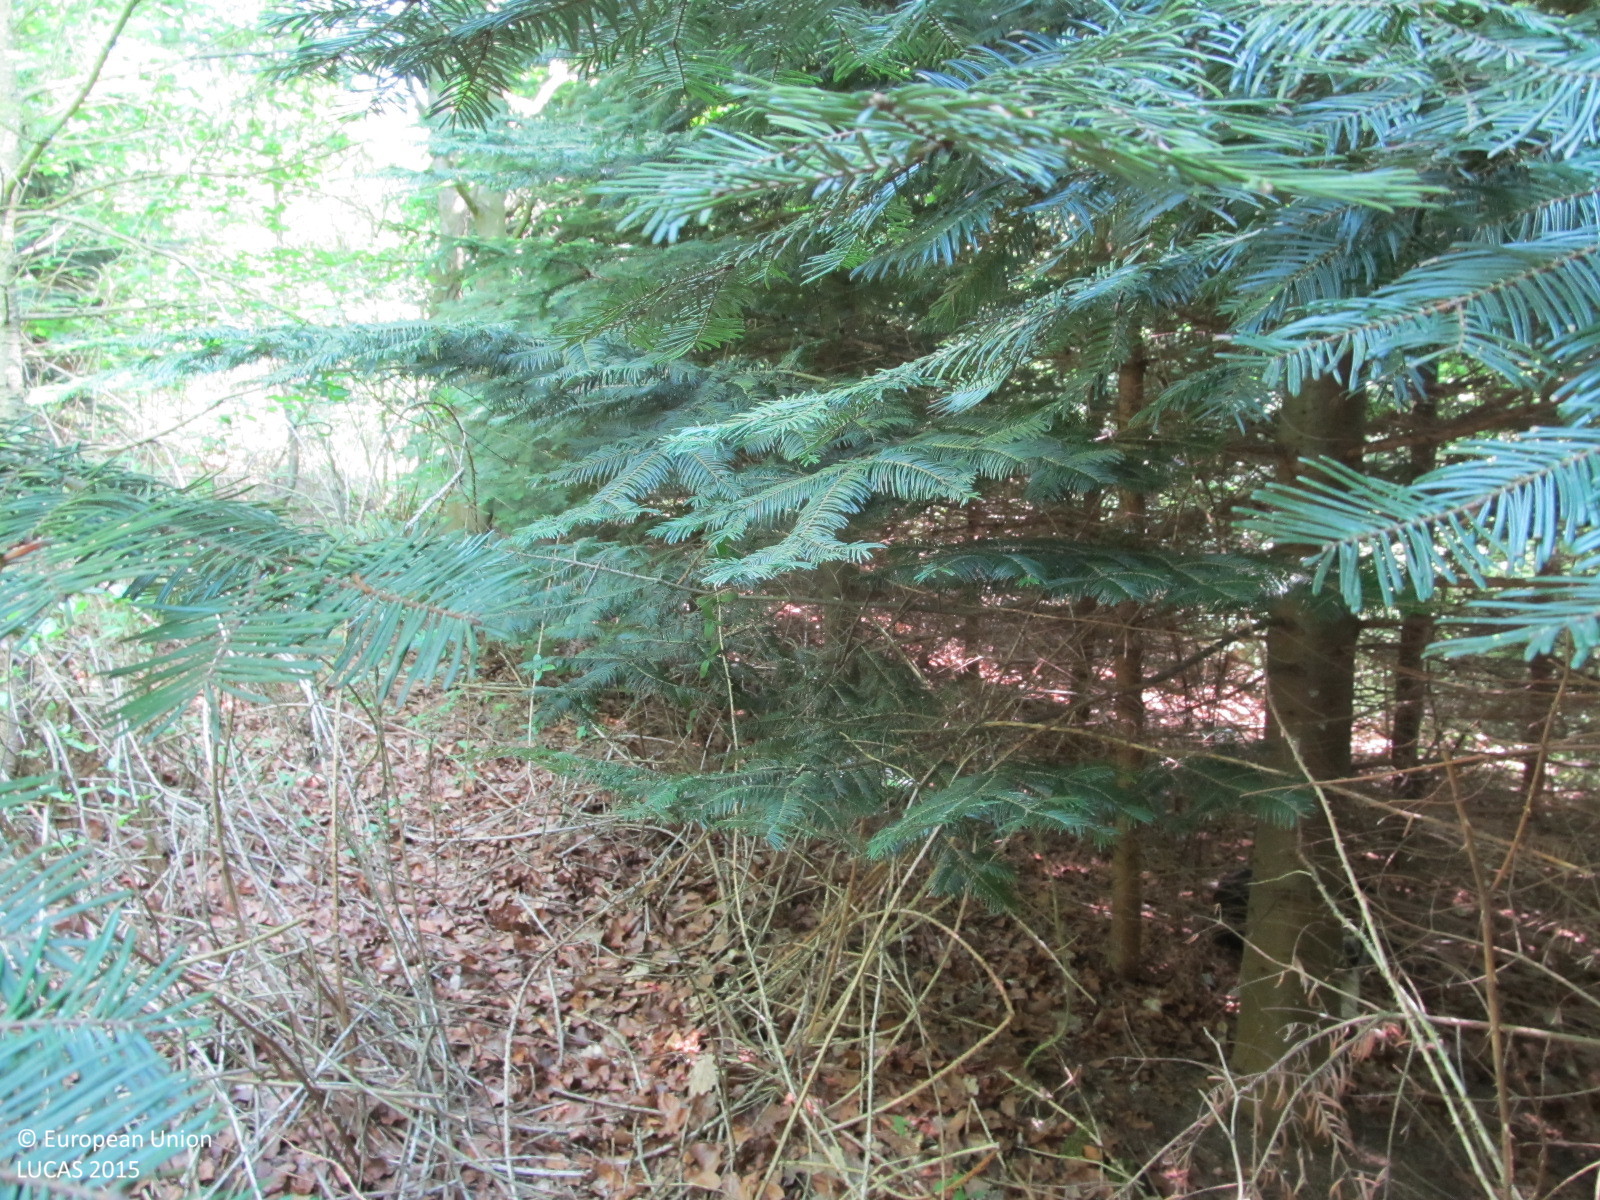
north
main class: Woodland
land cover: Other mixed woodland
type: hemiboreal forest and nemoral coniferous forest and mixed broadleaved-coniferous forest
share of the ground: > 75 %
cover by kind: coniferous forest trees 50 %, broadleaved forest trees 30 %, shrubs 10 %, herbaceous plants 10 %
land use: Forestry
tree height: > 5 m
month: May
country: AT
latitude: 48.6910
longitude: 15.6684
